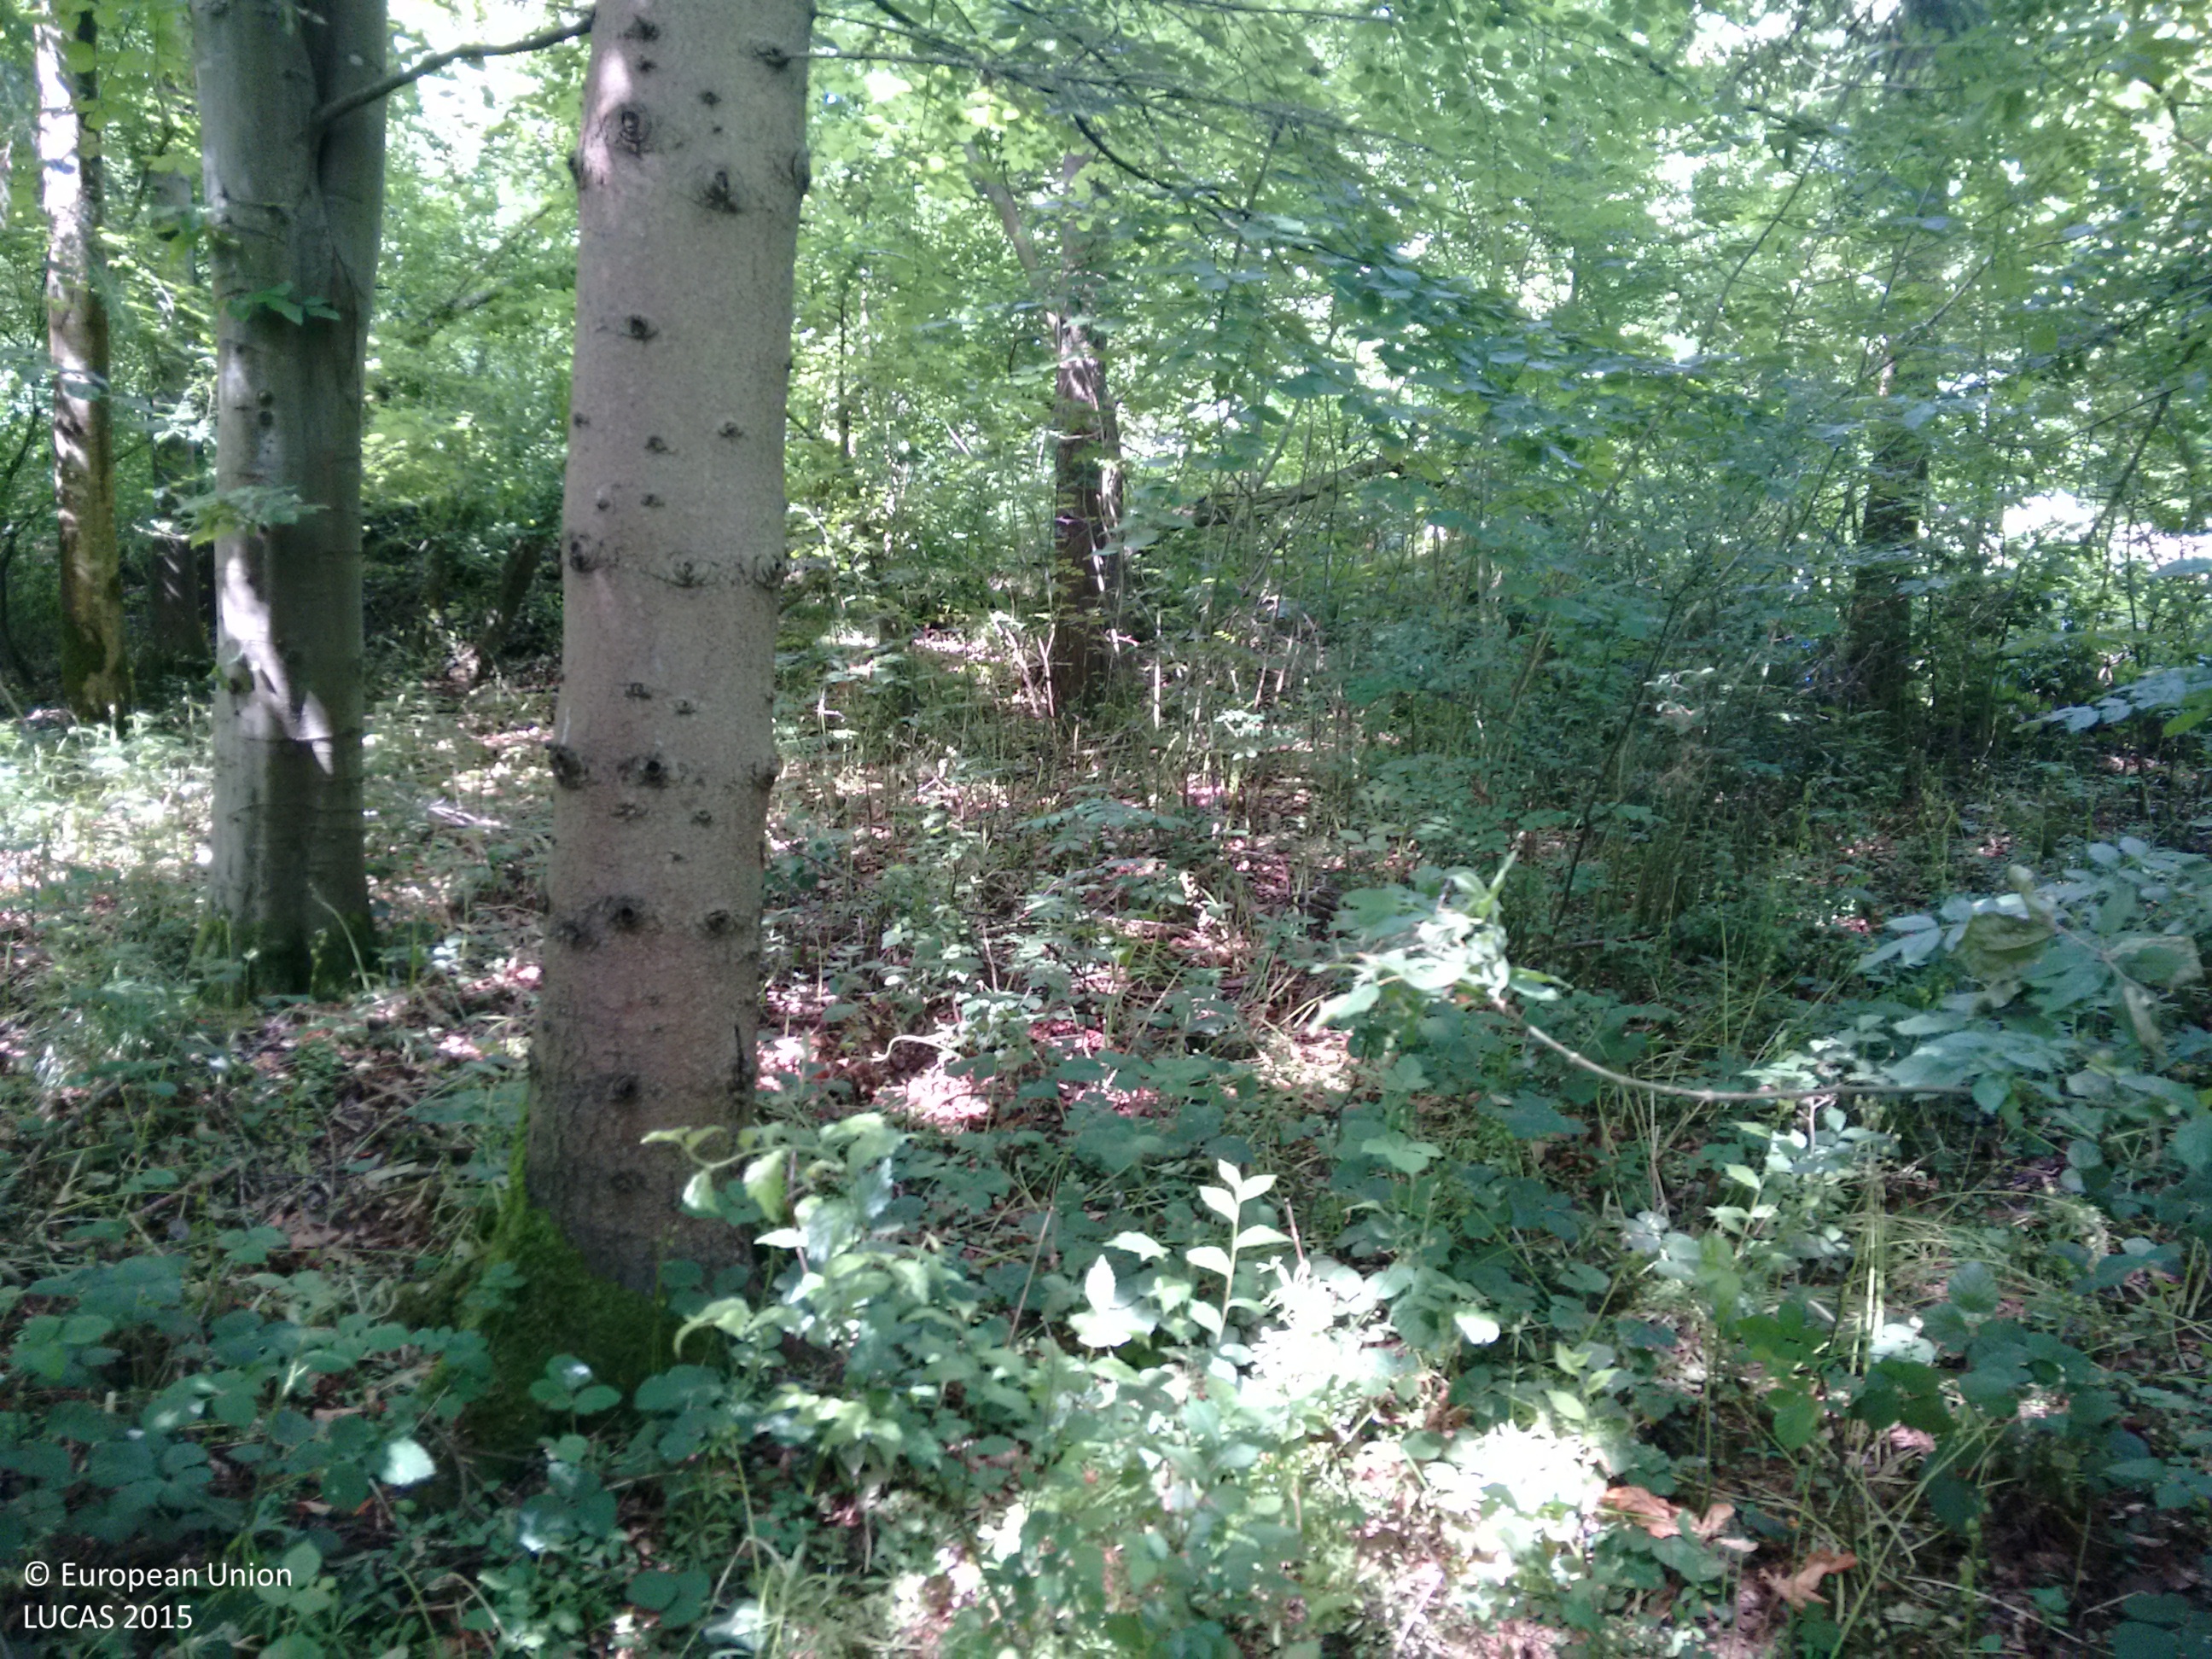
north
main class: Woodland
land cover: Broadleaved woodland
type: mesophytic deciduous forest
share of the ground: > 75 %
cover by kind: broadleaved forest trees 80 %, coniferous forest trees 20 %
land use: Forestry
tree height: > 5 m
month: June
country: GB
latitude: 51.3429
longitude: -2.2215
